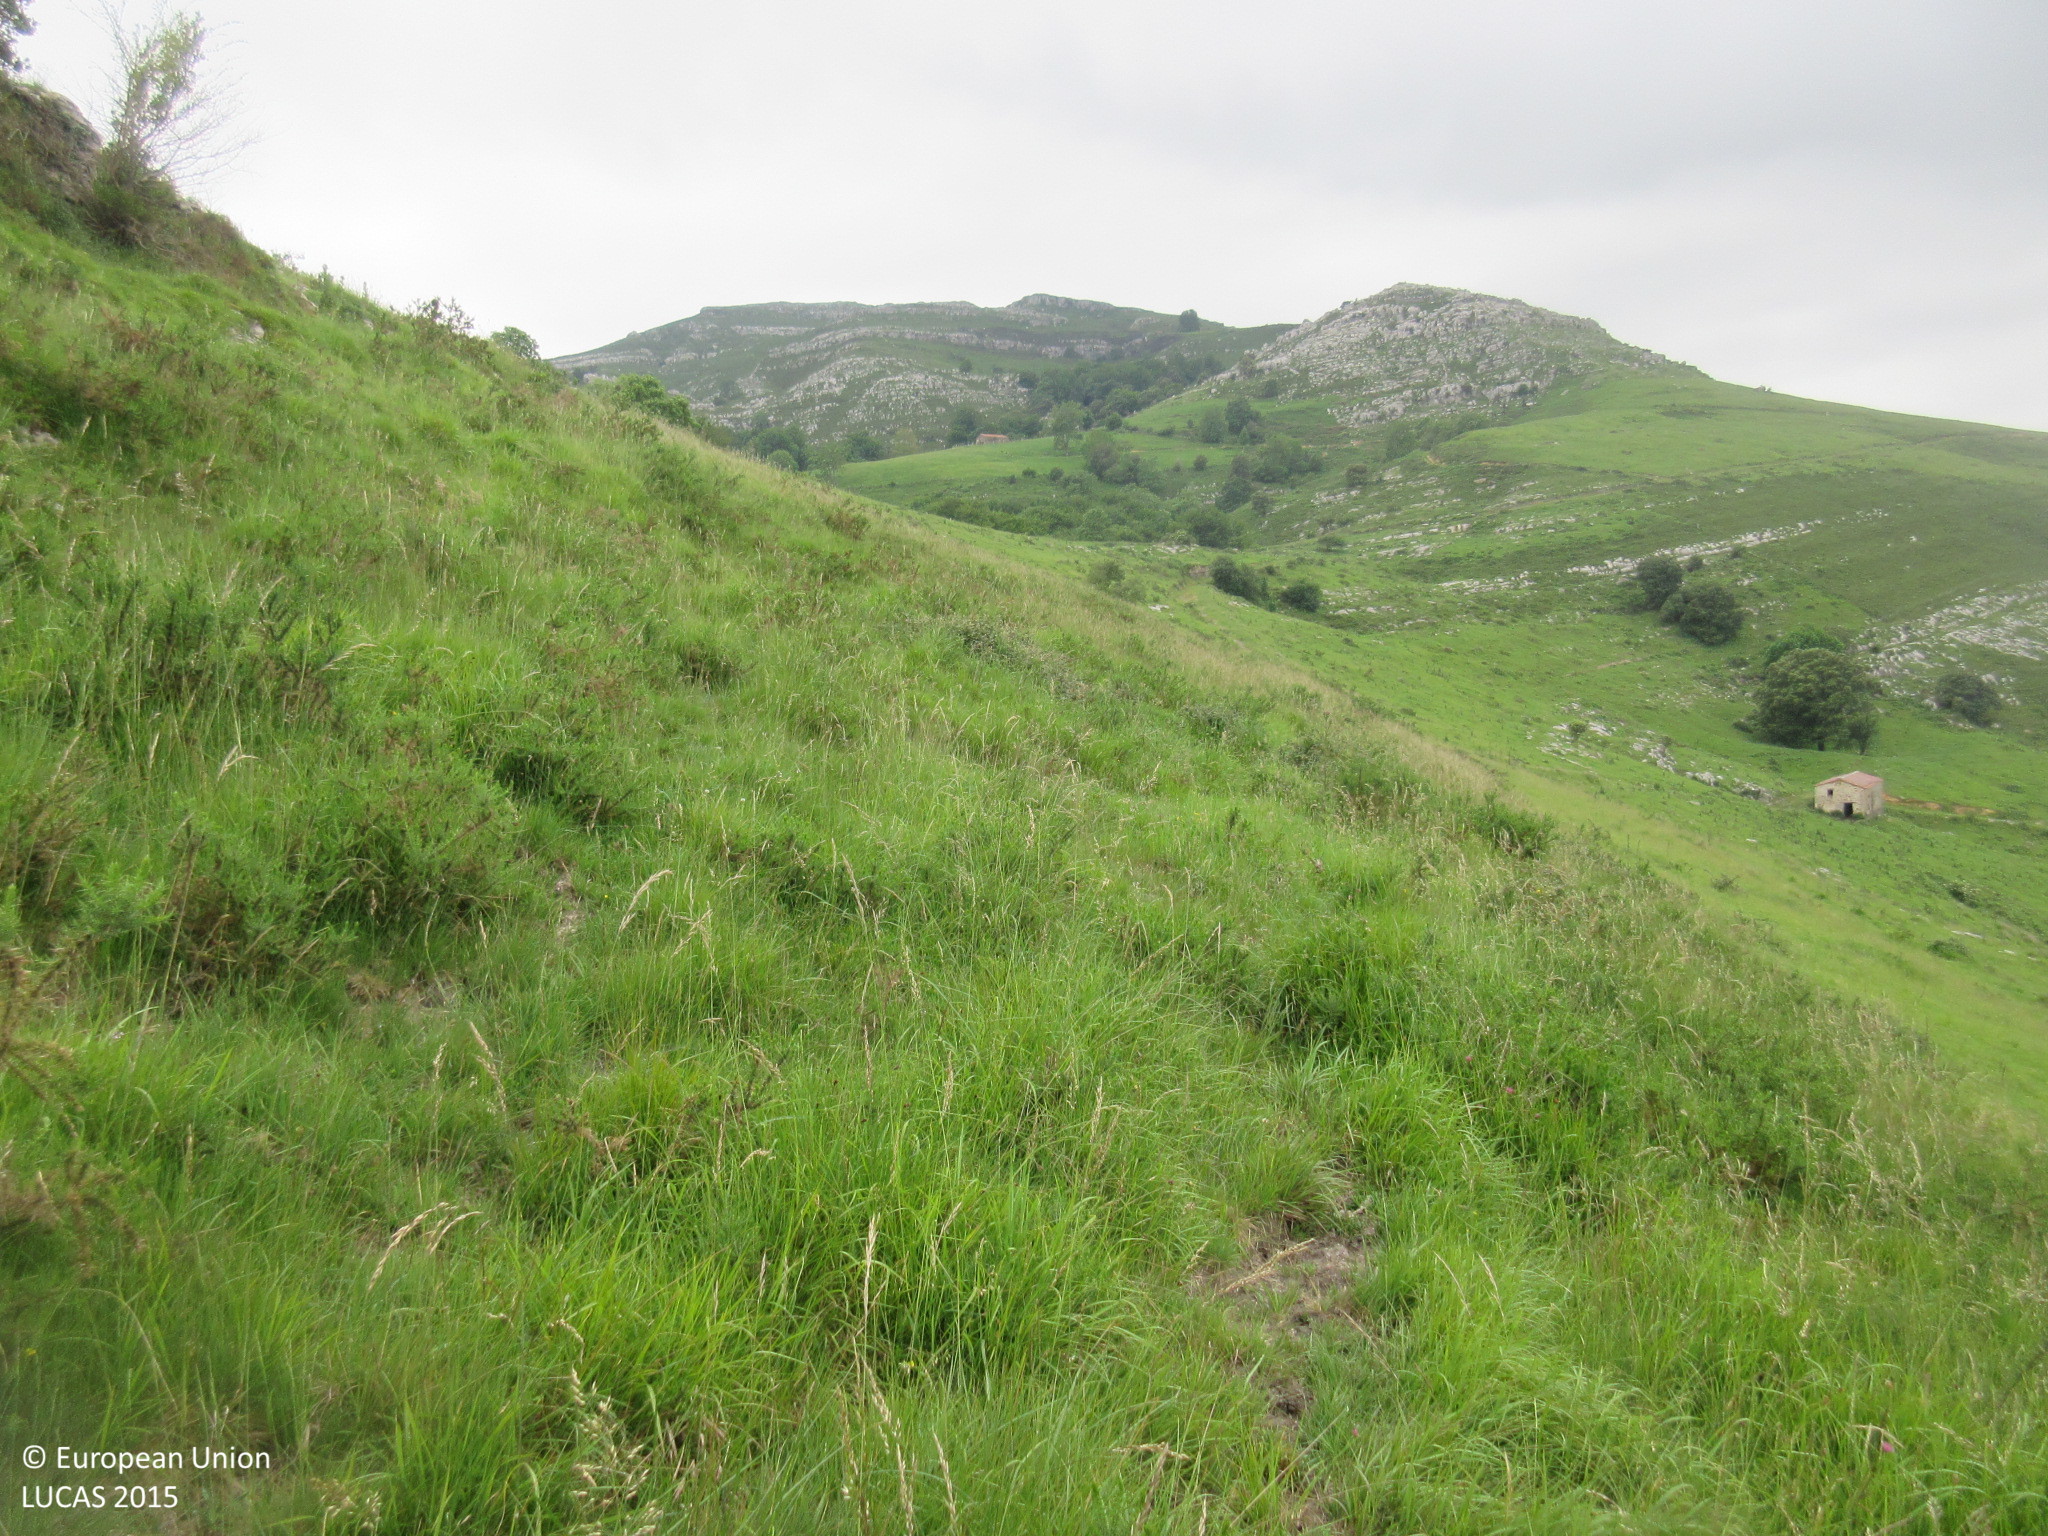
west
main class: Grassland
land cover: Grassland without tree/shrub cover
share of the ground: > 75 %
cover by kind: herbaceous plants 95 %, shrubs 5 %
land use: Agriculture (excluding fallow land and kitchen gardens)
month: June
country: ES
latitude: 43.3052
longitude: -3.5926
